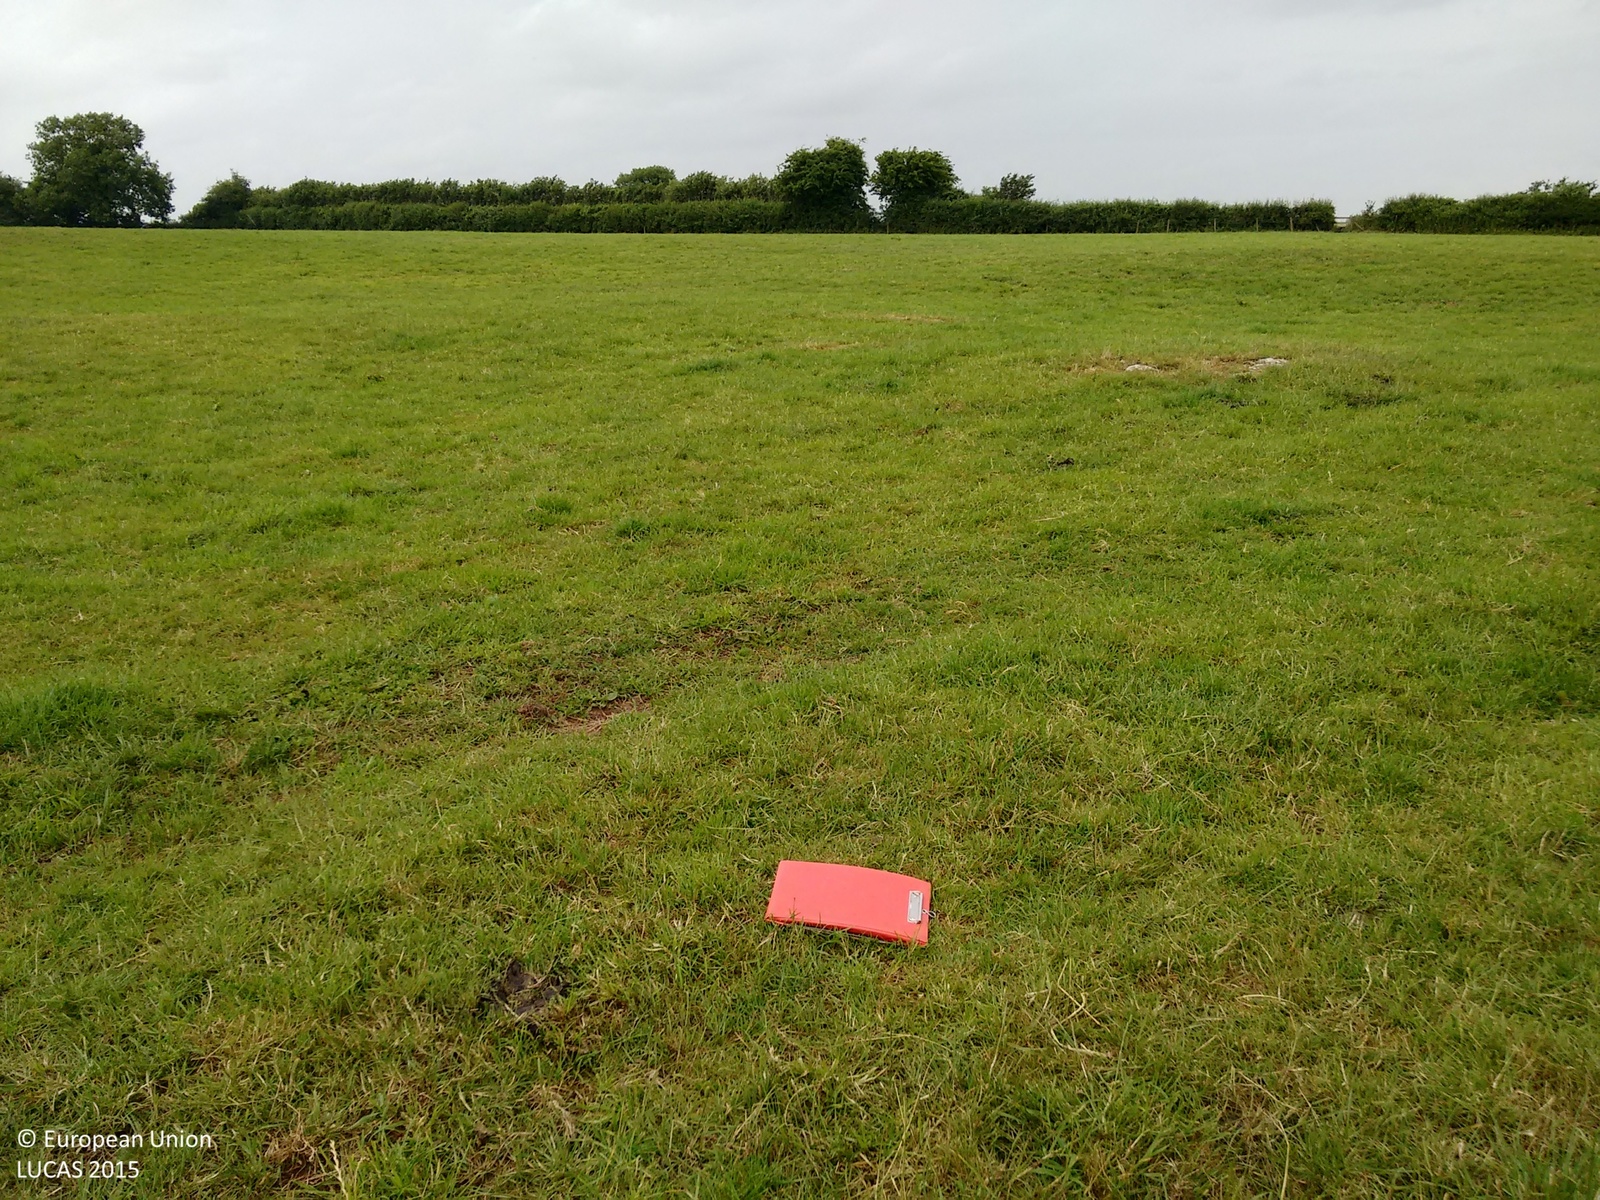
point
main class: Grassland
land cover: Grassland without tree/shrub cover
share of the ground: > 75 %
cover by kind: herbaceous plants 100 %
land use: Agriculture (excluding fallow land and kitchen gardens)
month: July
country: GB
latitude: 51.2242
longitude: -2.4806
